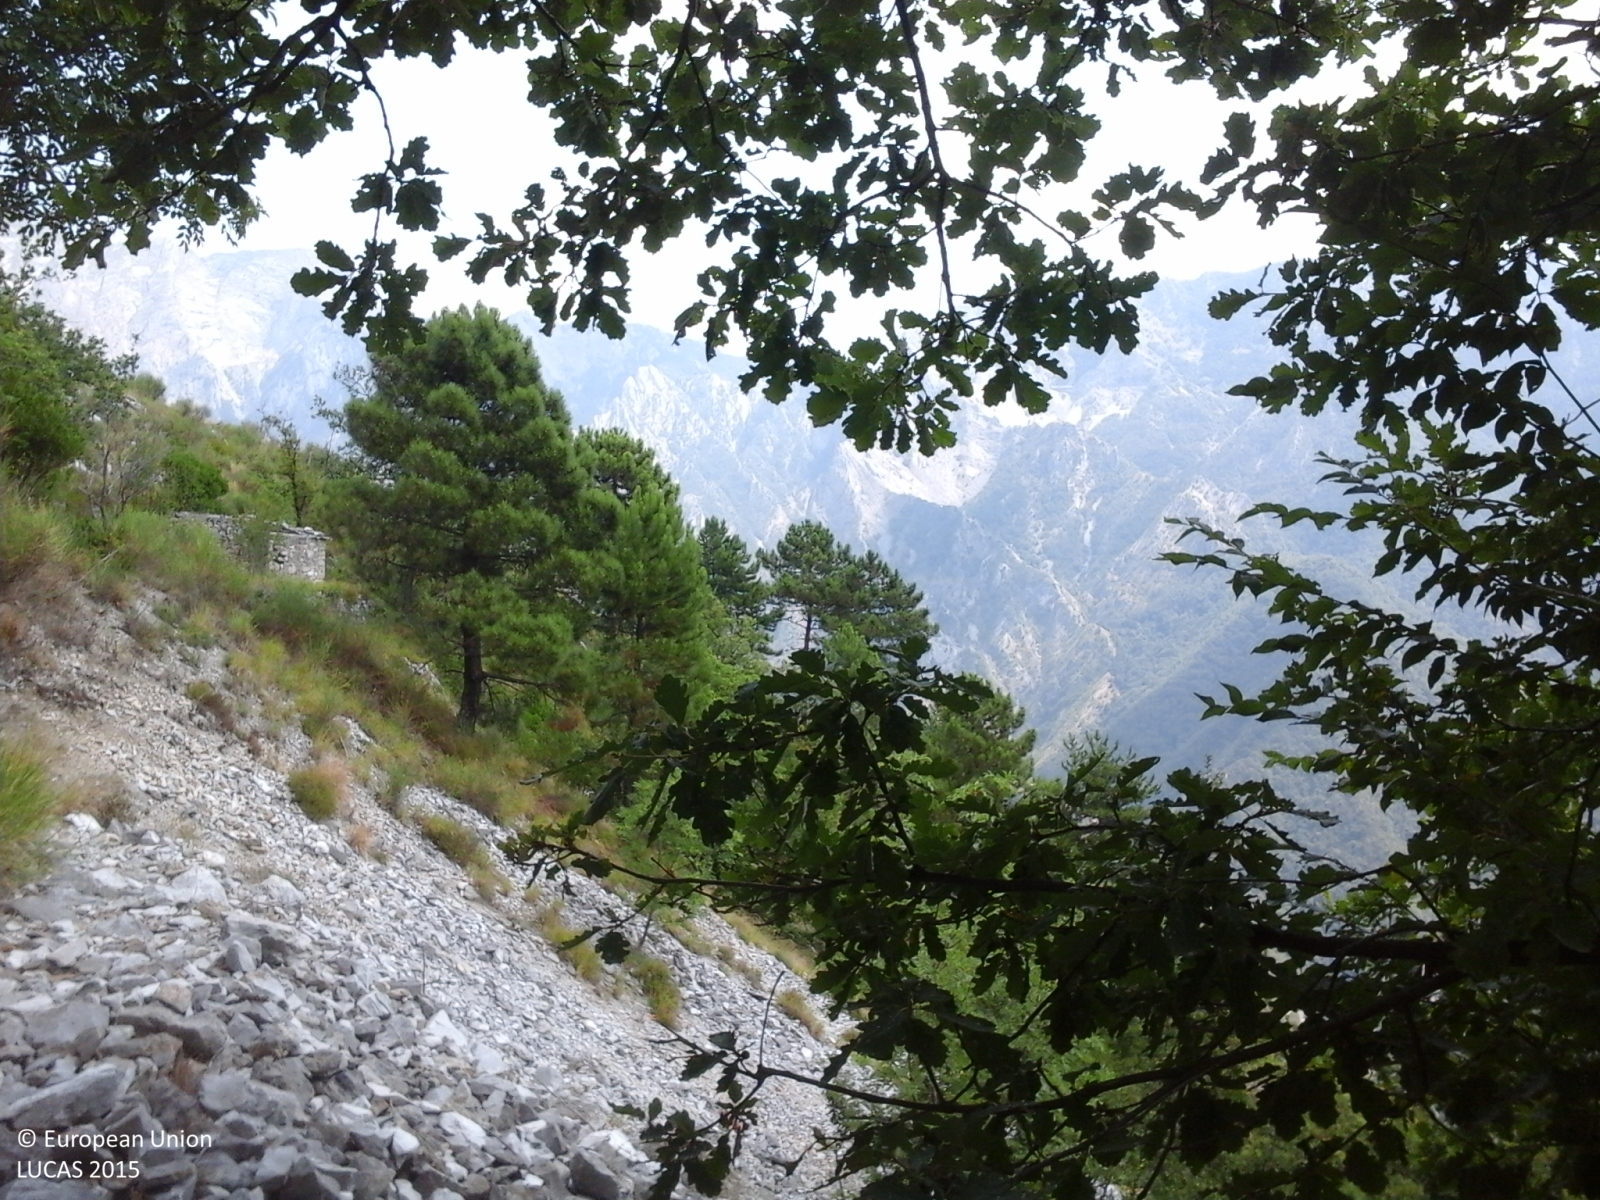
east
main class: Woodland
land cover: Other mixed woodland
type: thermophilous deciduous forest
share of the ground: > 75 %
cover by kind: broadleaved forest trees 50 %, unconsolidated bare surface 30 %, coniferous forest trees 20 %
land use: Forestry
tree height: > 5 m
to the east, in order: Other mixed woodland; Rocks and stones; Other mixed woodland
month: August
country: IT
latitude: 44.0798
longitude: 10.1868
